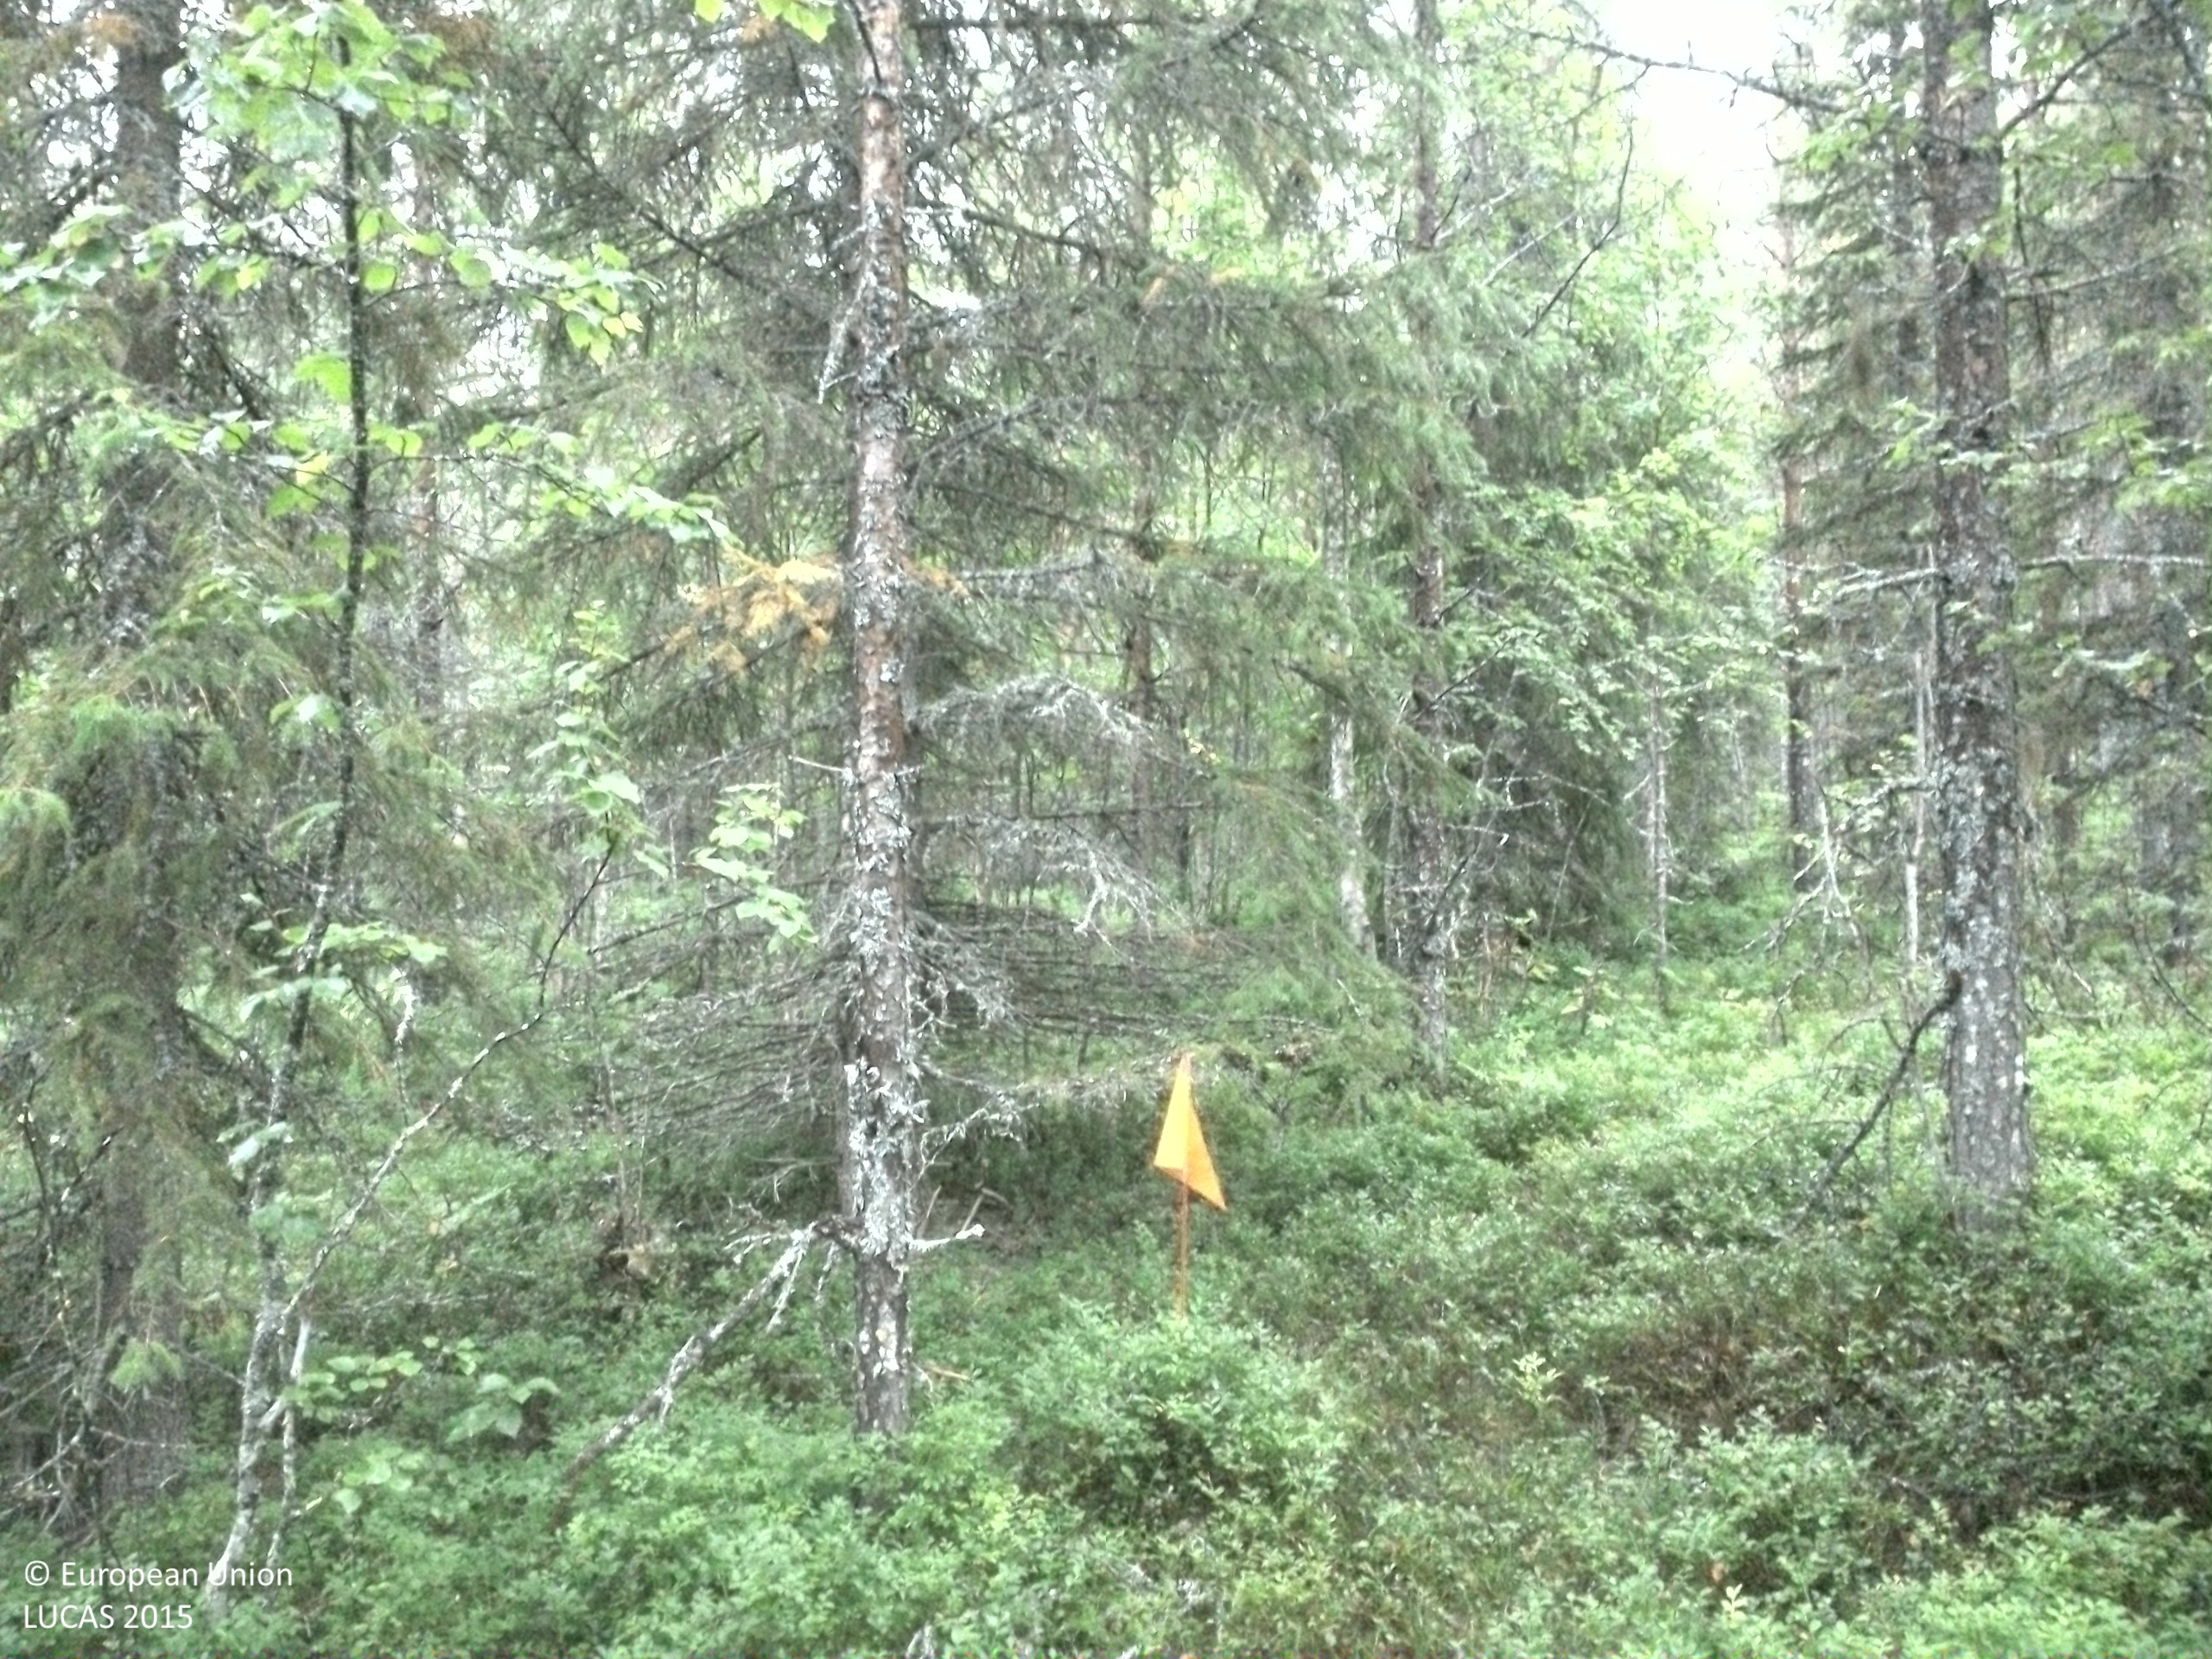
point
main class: Woodland
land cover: Spruce dominated coniferous woodland
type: boreal forest
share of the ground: > 75 %
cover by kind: coniferous forest trees 75 %, shrubs 15 %, broadleaved forest trees 10 %
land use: Forestry
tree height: > 5 m
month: August
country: SE
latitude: 63.8467
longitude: 17.3530
